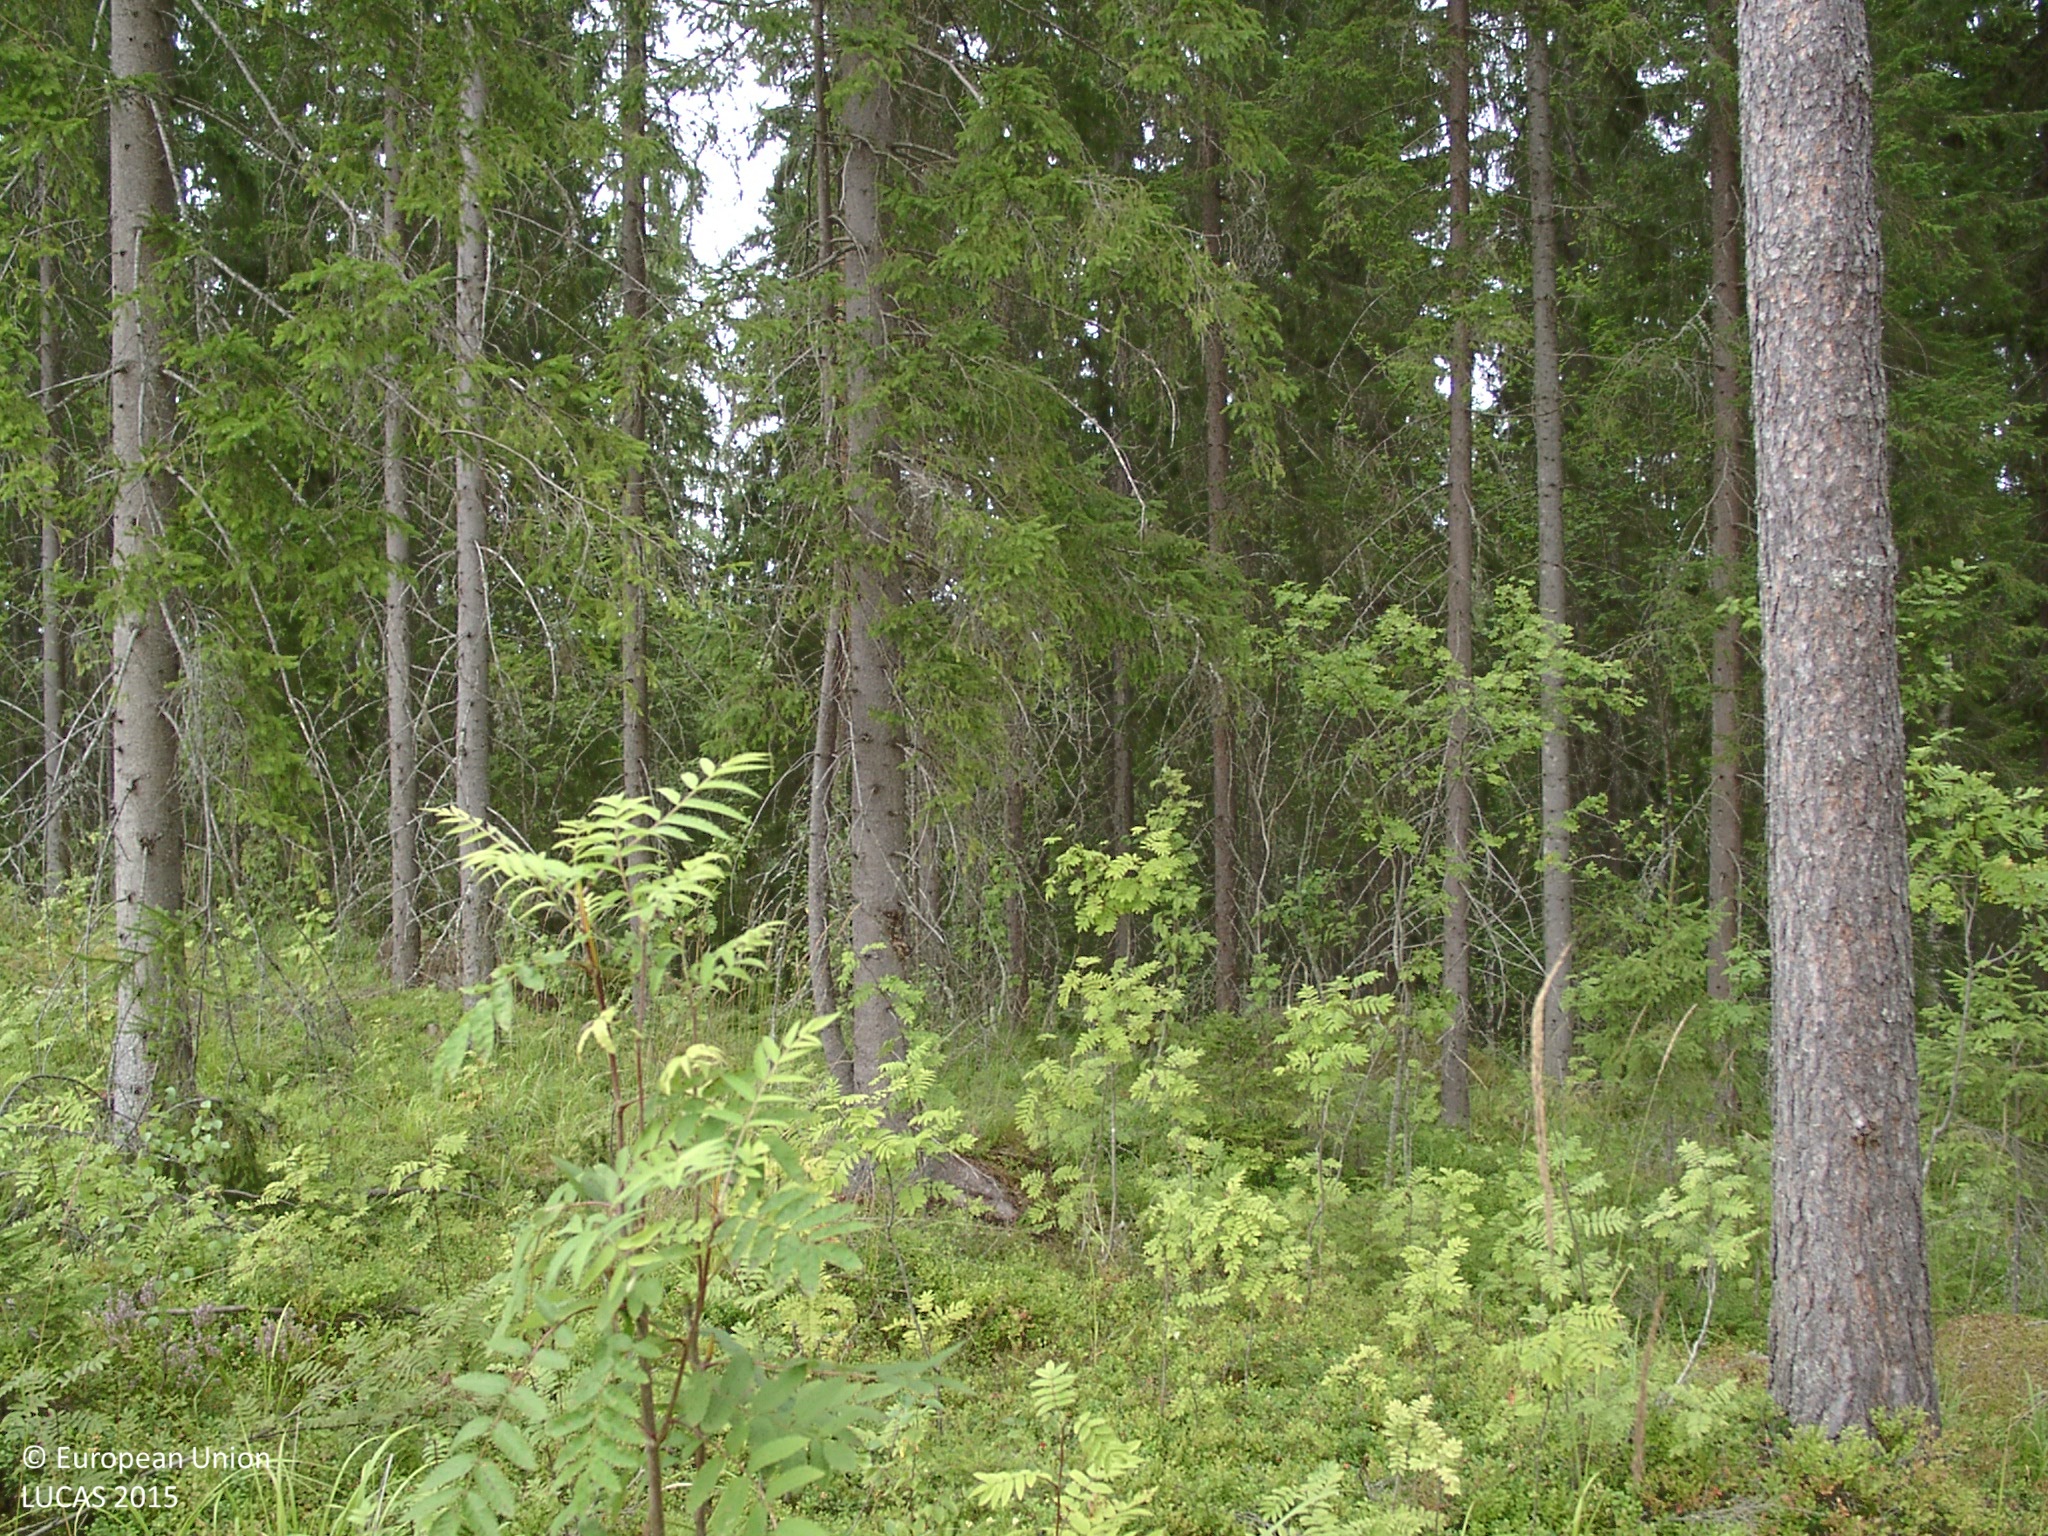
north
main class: Woodland
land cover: Other coniferous woodland
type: boreal forest
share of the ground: 50 - 75 %
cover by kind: coniferous forest trees 55 %, shrubs 15 %, broadleaved forest trees 10 %, herbaceous plants 10 %, lichens and mosses 10 %
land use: Forestry
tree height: > 5 m
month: August
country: FI
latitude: 61.7786
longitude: 25.3756
